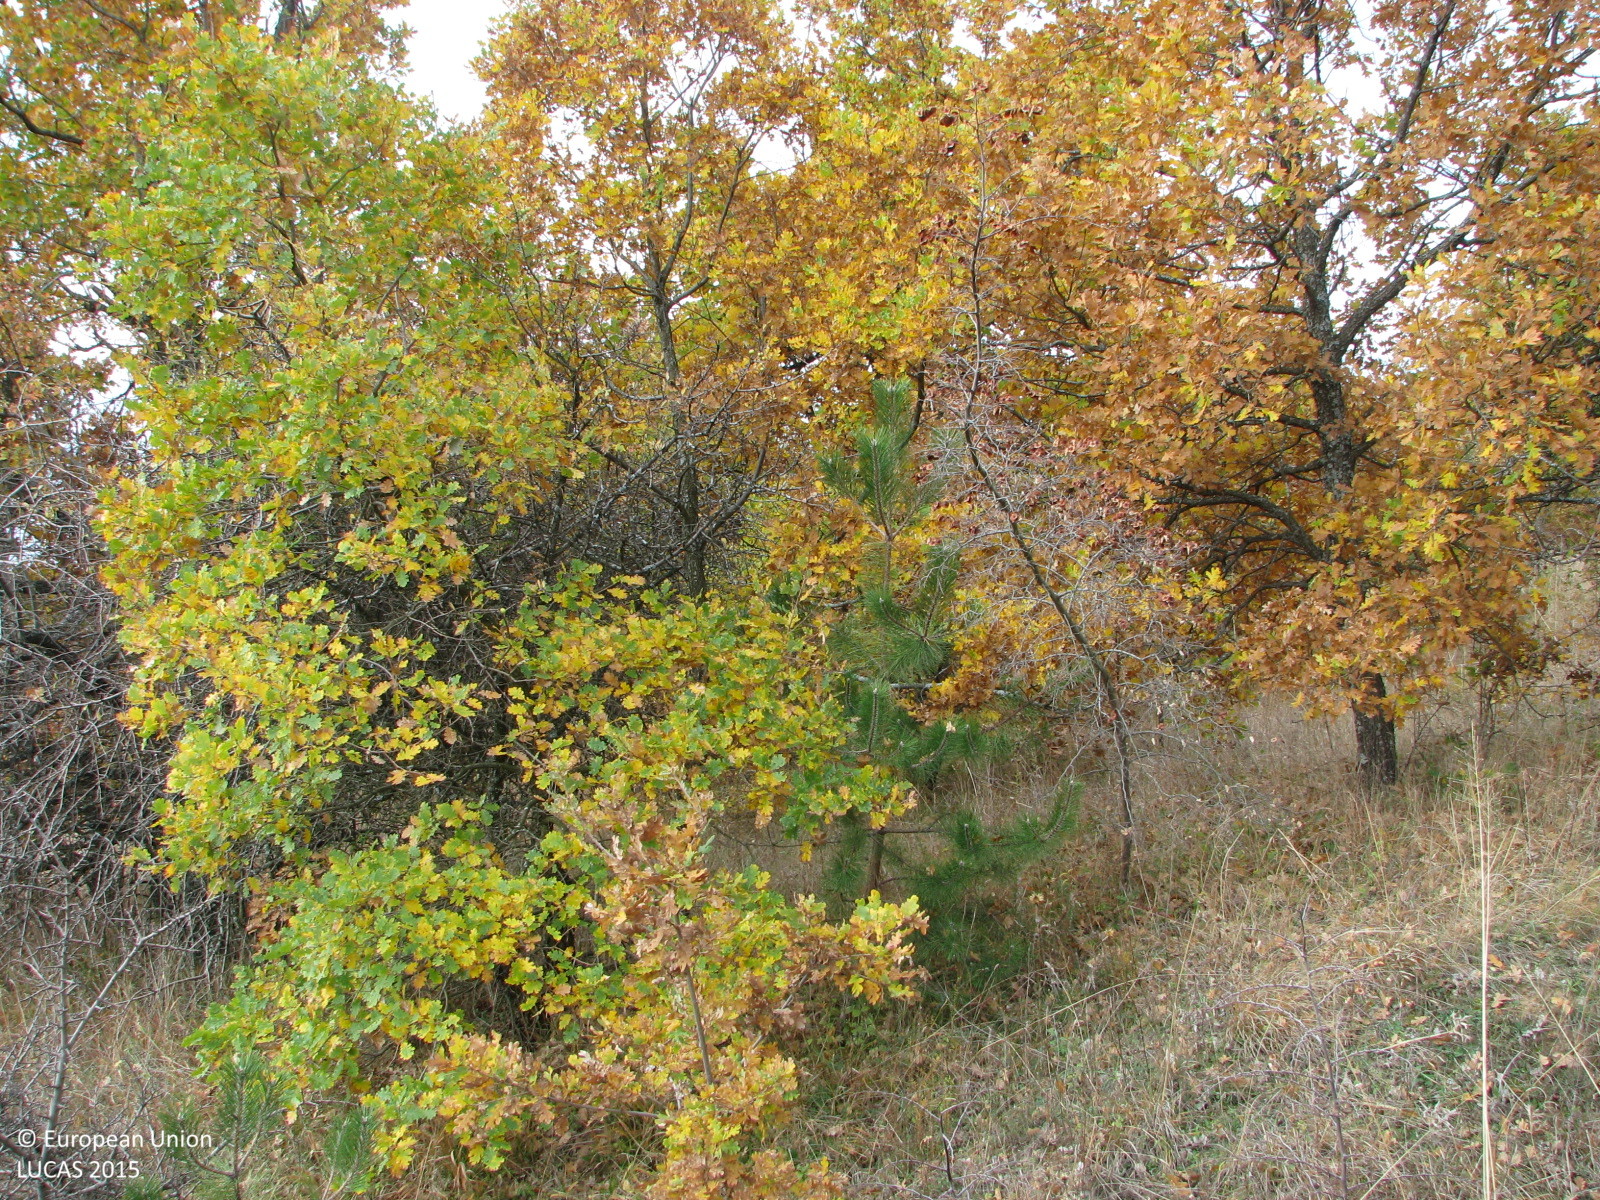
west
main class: Woodland
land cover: Broadleaved woodland
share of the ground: 25 - 50 %
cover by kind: herbaceous plants 50 %, broadleaved forest trees 35 %, shrubs 15 %
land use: Semi-natural and natural areas not in use
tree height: < 5 m
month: November
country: BG
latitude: 41.9046
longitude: 26.3427
